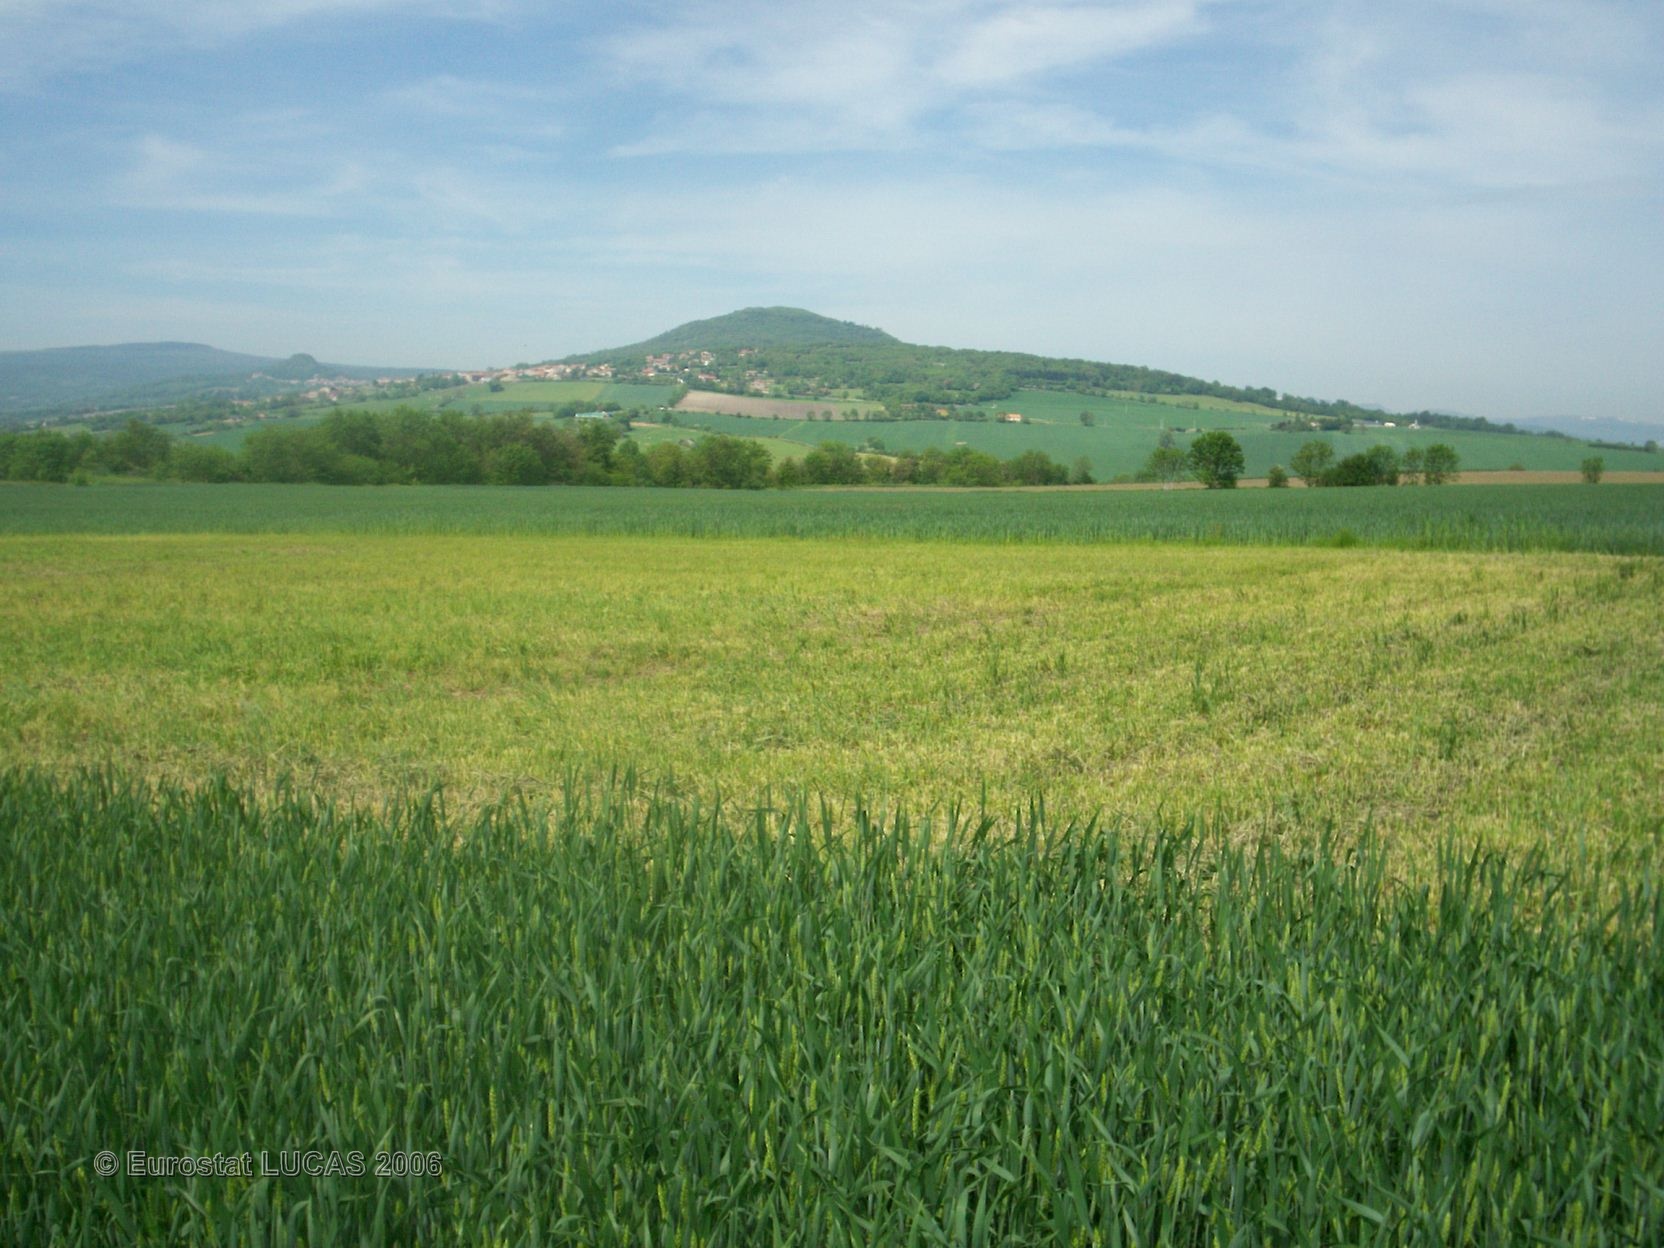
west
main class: Cropland
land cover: Common wheat
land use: Agriculture (excluding fallow land and kitchen gardens)
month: May
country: FR
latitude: 45.5203
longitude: 3.2029
